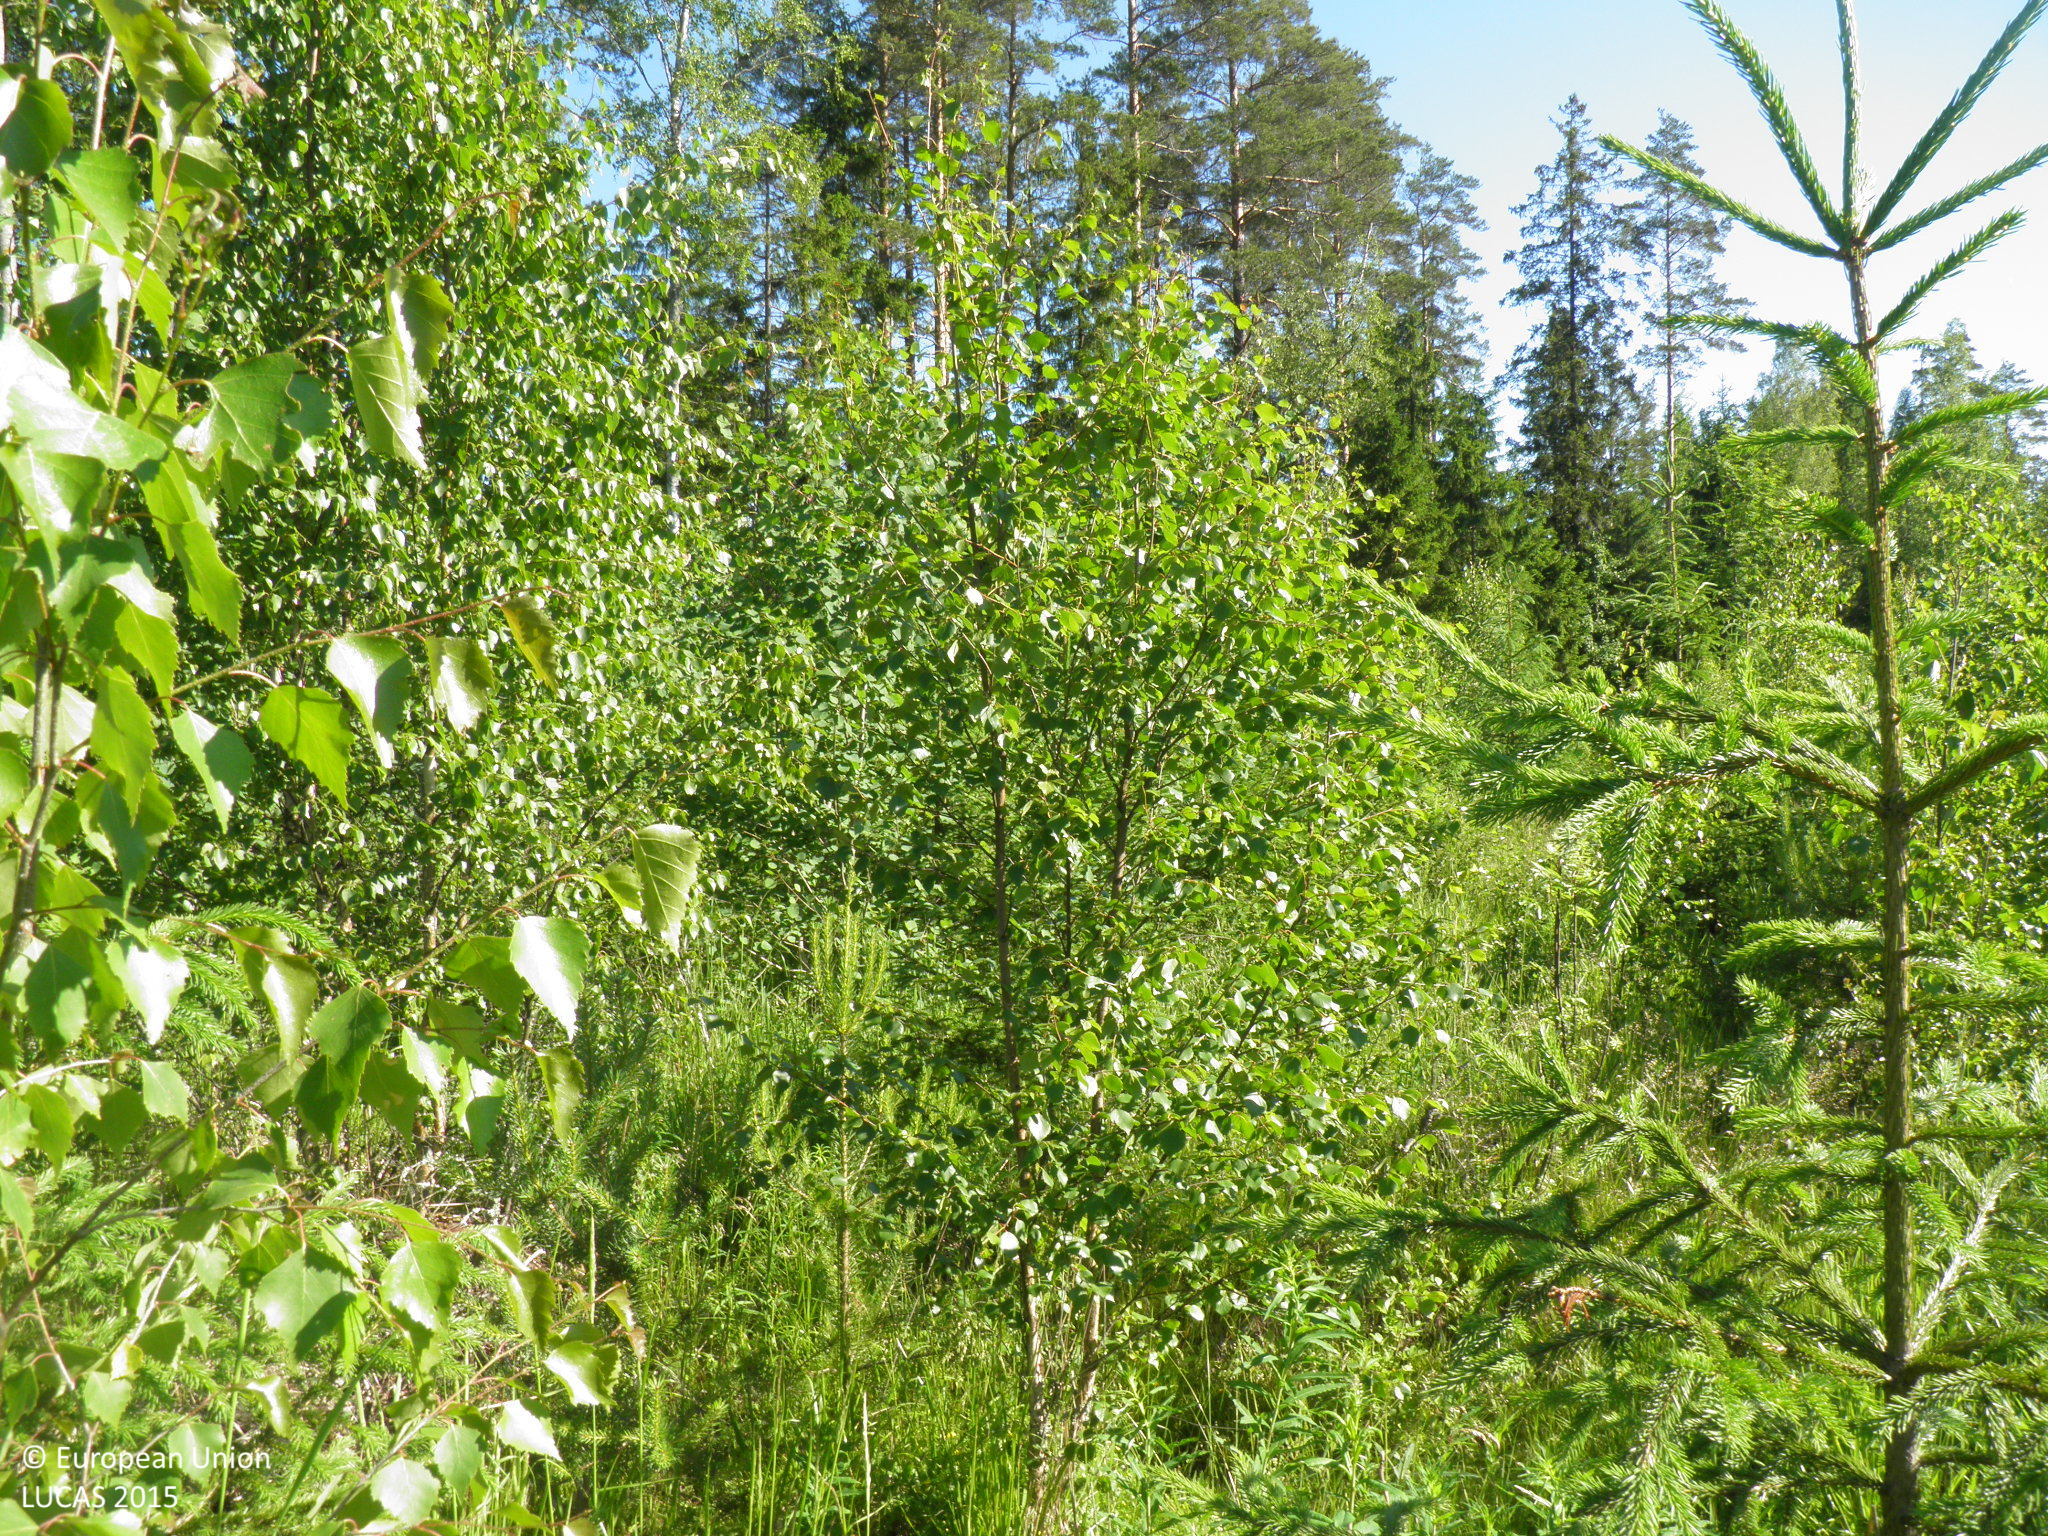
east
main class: Woodland
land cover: Other mixed woodland
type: hemiboreal forest and nemoral coniferous forest and mixed broadleaved-coniferous forest
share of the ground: 50 - 75 %
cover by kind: broadleaved forest trees 55 %, coniferous forest trees 20 %, herbaceous plants 15 %, shrubs 10 %
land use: Forestry
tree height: < 5 m
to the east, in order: Other mixed woodland; Pine dominated coniferous woodland
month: July
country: FI
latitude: 60.5256
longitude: 22.8105
